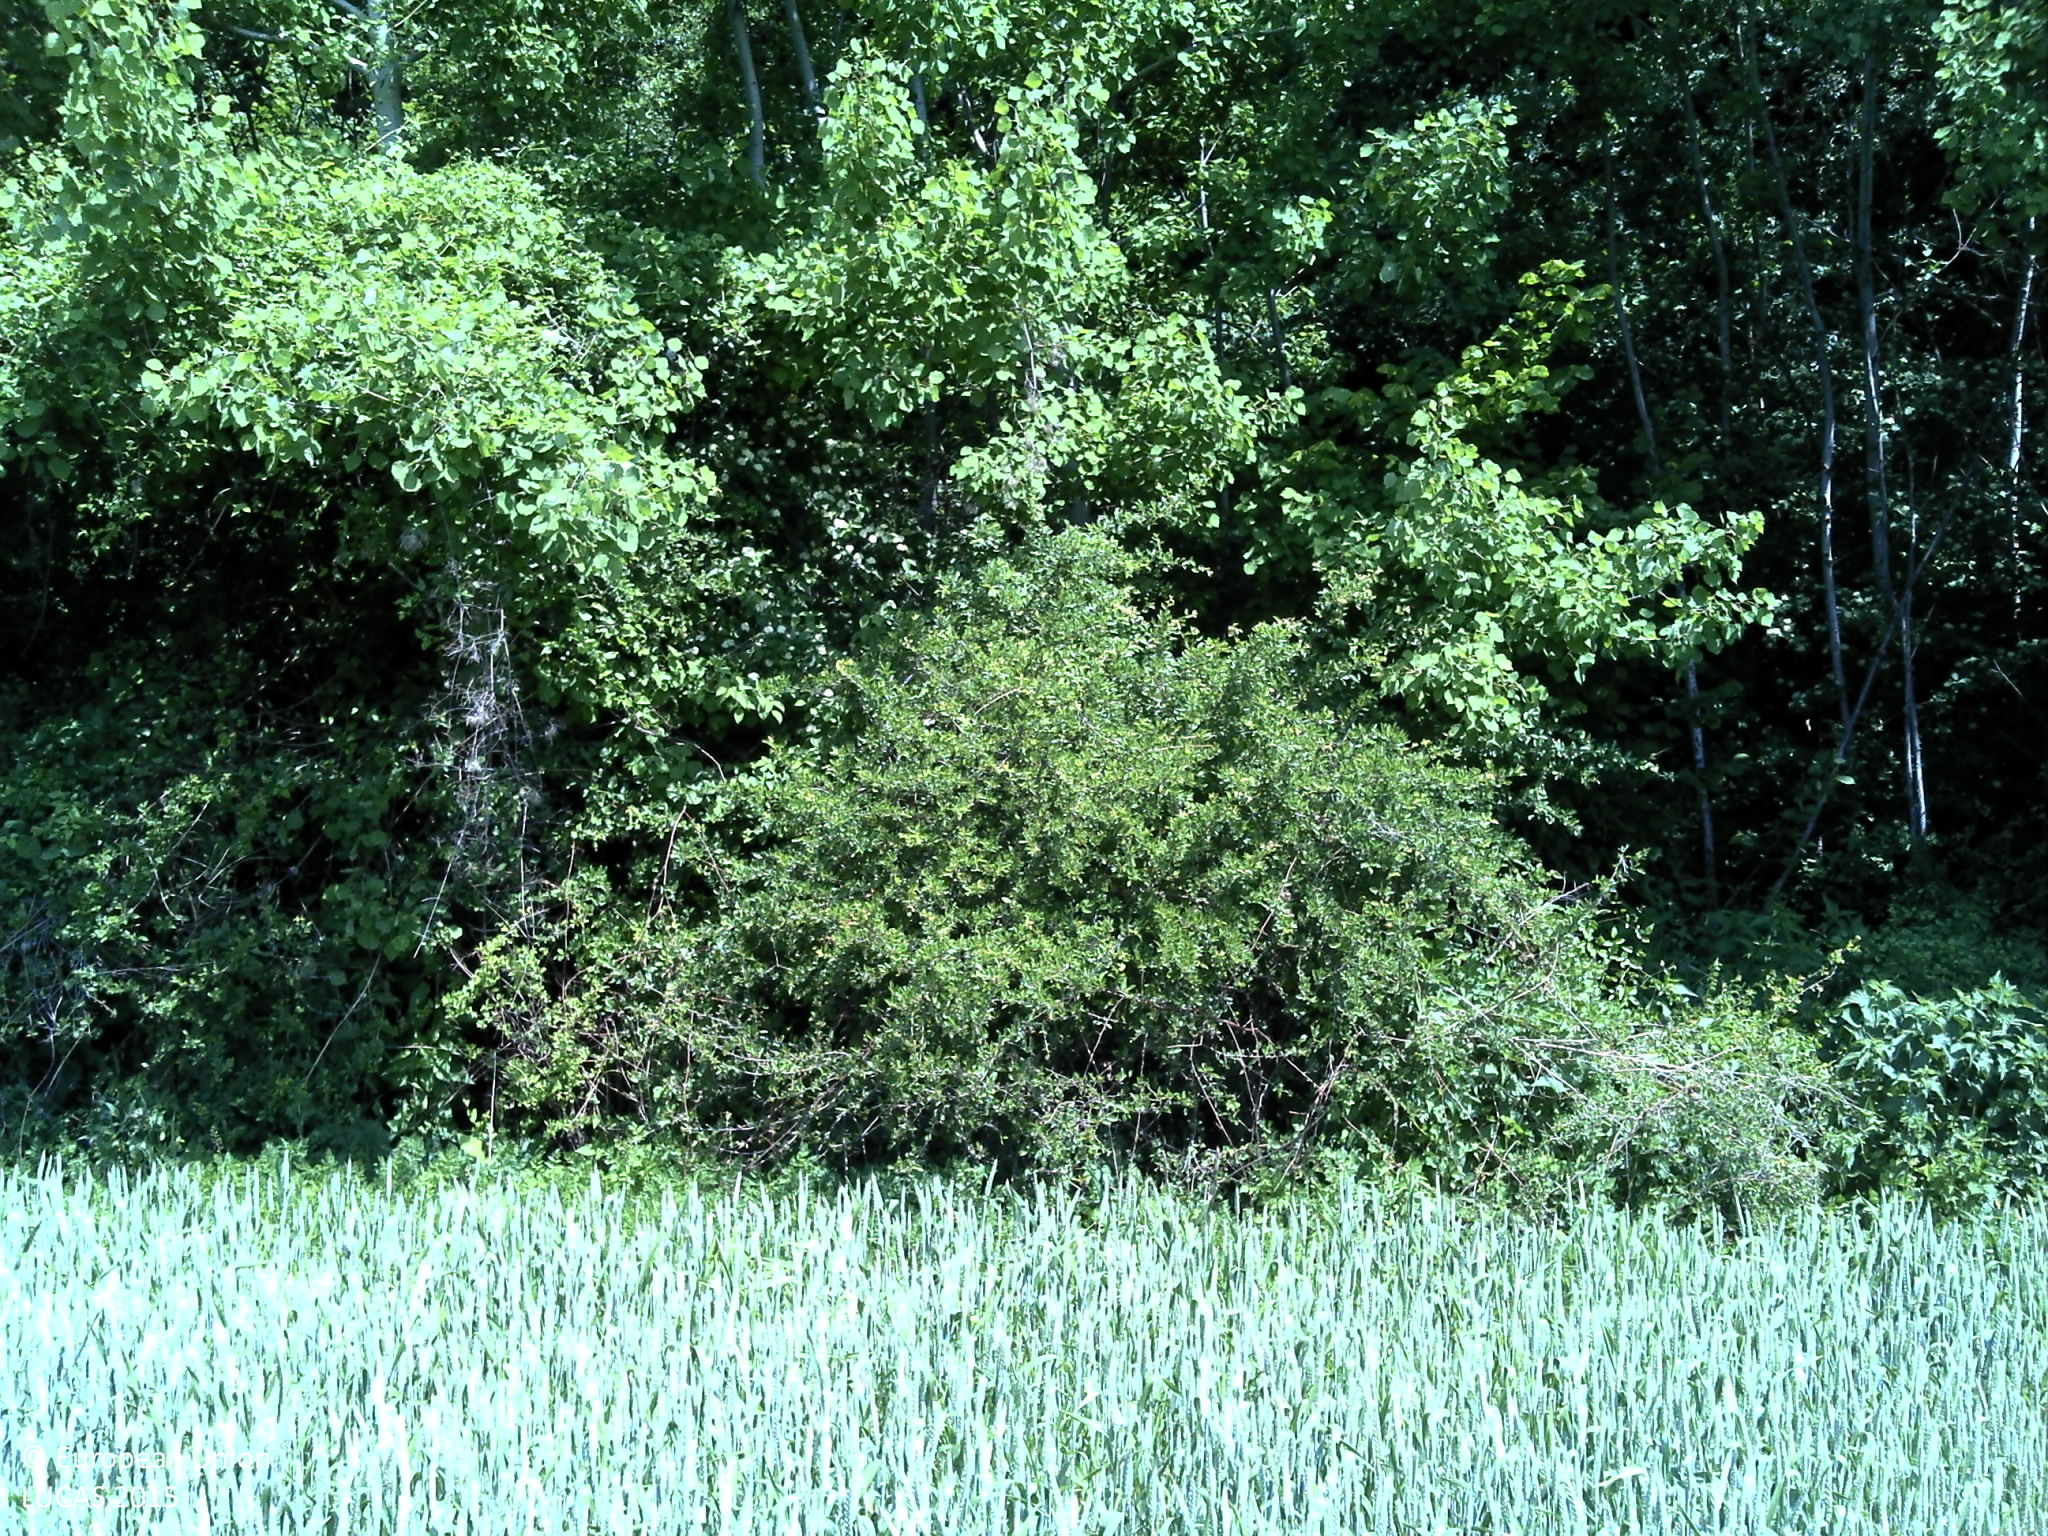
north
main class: Cropland
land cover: Common wheat
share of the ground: > 75 %
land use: Agriculture (excluding fallow land and kitchen gardens)
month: May
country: HR
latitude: 45.5102
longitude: 18.2096
